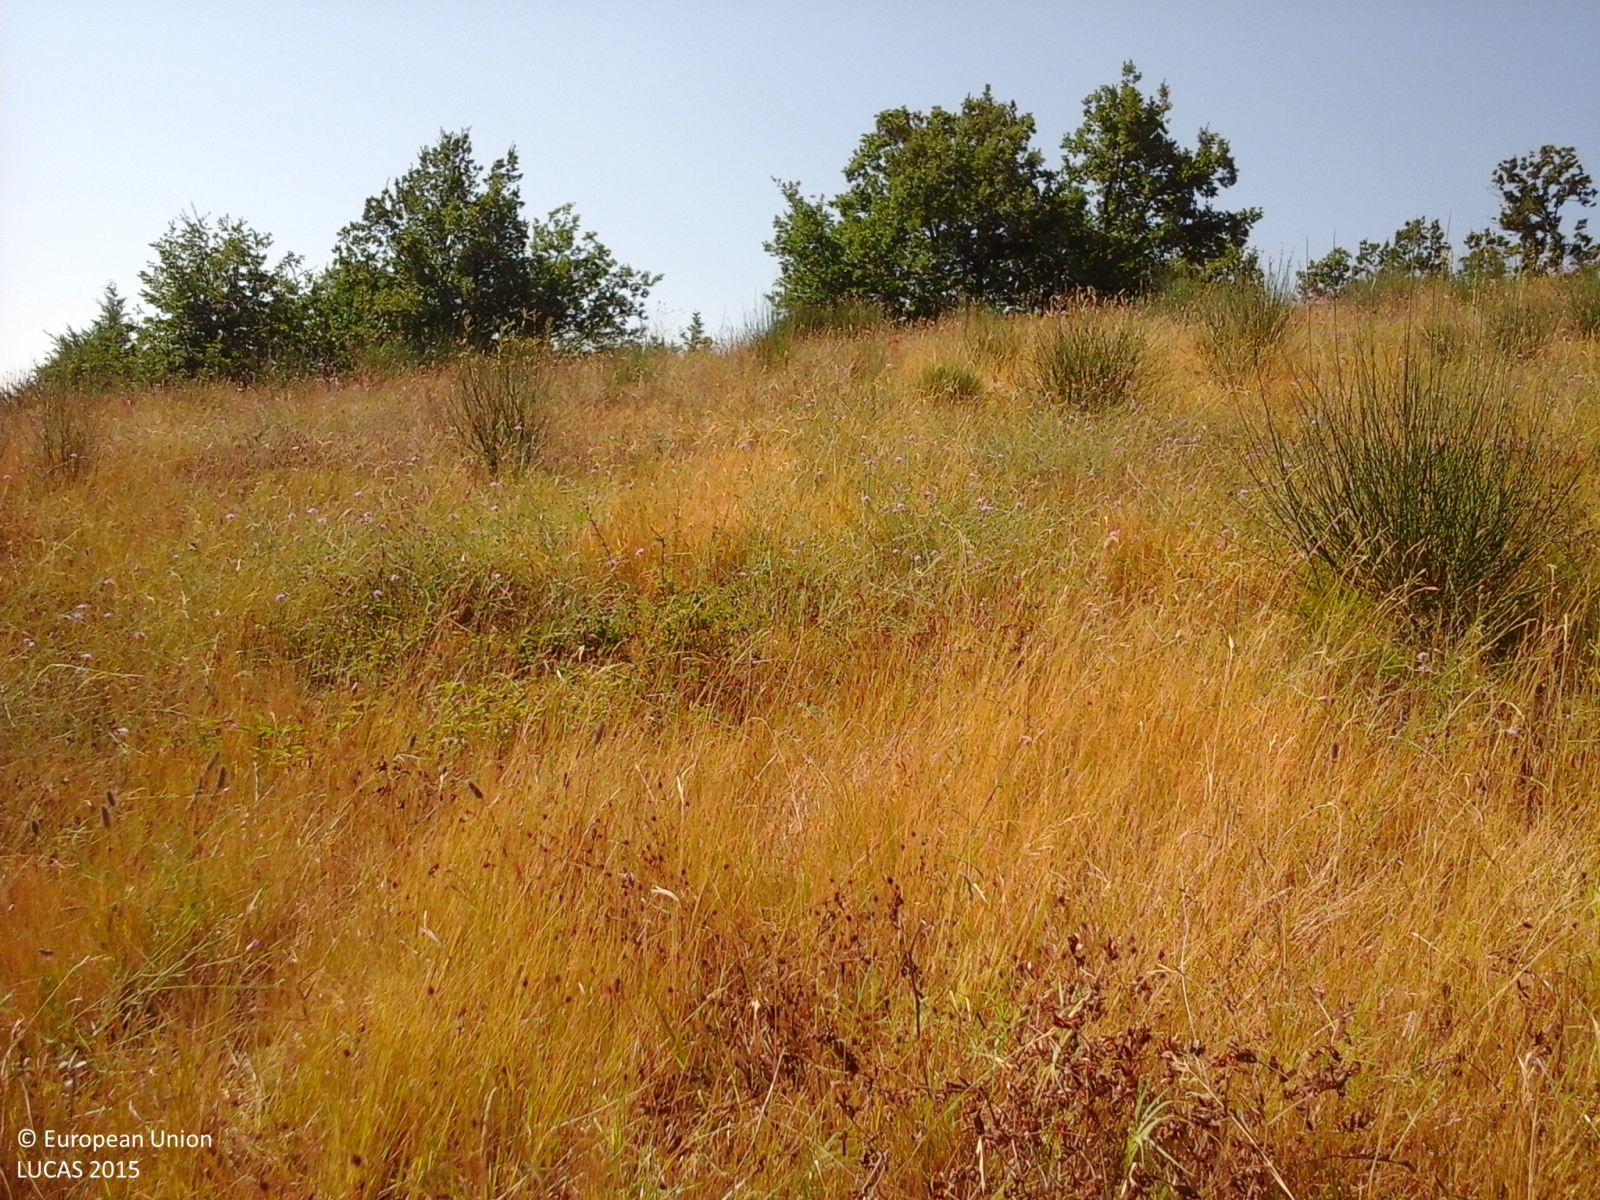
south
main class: Grassland
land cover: Grassland with sparse tree/shrub cover
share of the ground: > 75 %
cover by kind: herbaceous plants 85 %, shrubs 10 %, broadleaved forest trees 5 %
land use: Semi-natural and natural areas not in use
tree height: < 5 m
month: August
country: IT
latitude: 43.6692
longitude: 12.5608
